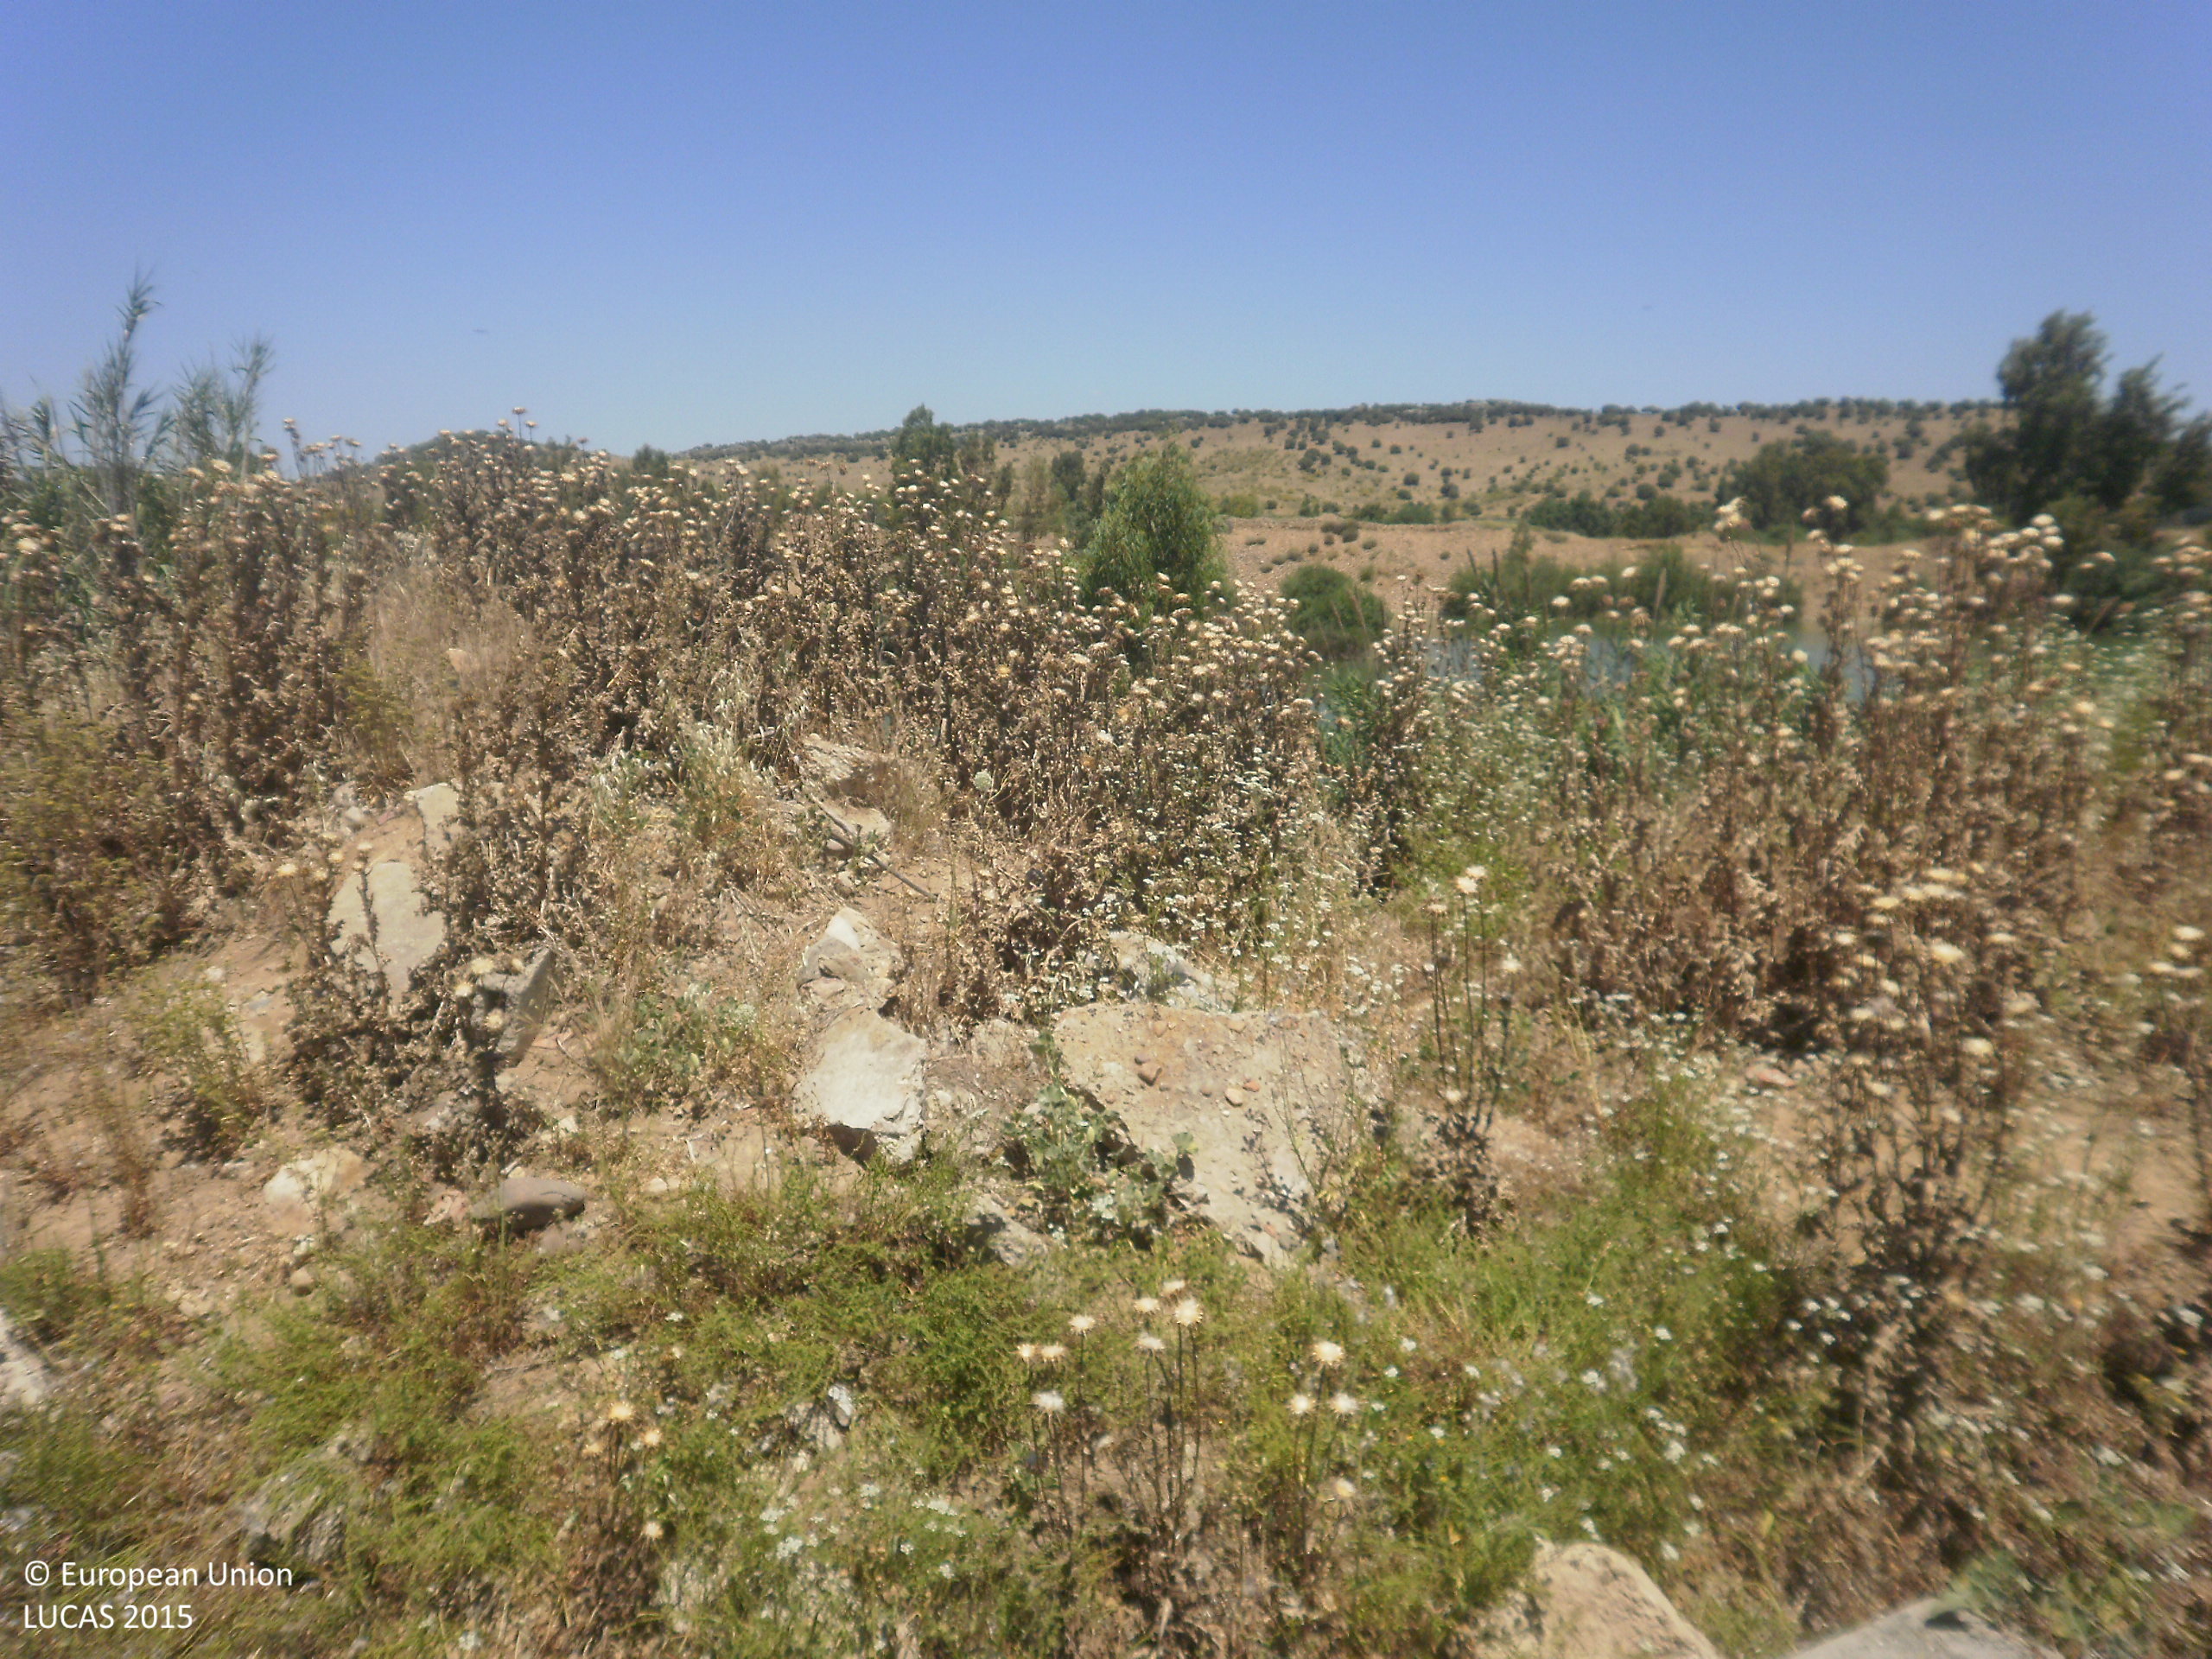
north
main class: Shrubland
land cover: Shrubland without tree cover
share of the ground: 25 - 50 %
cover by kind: herbaceous plants 70 %, shrubs 30 %
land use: Mining and quarrying
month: May
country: ES
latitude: 39.0163
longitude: -5.7908
